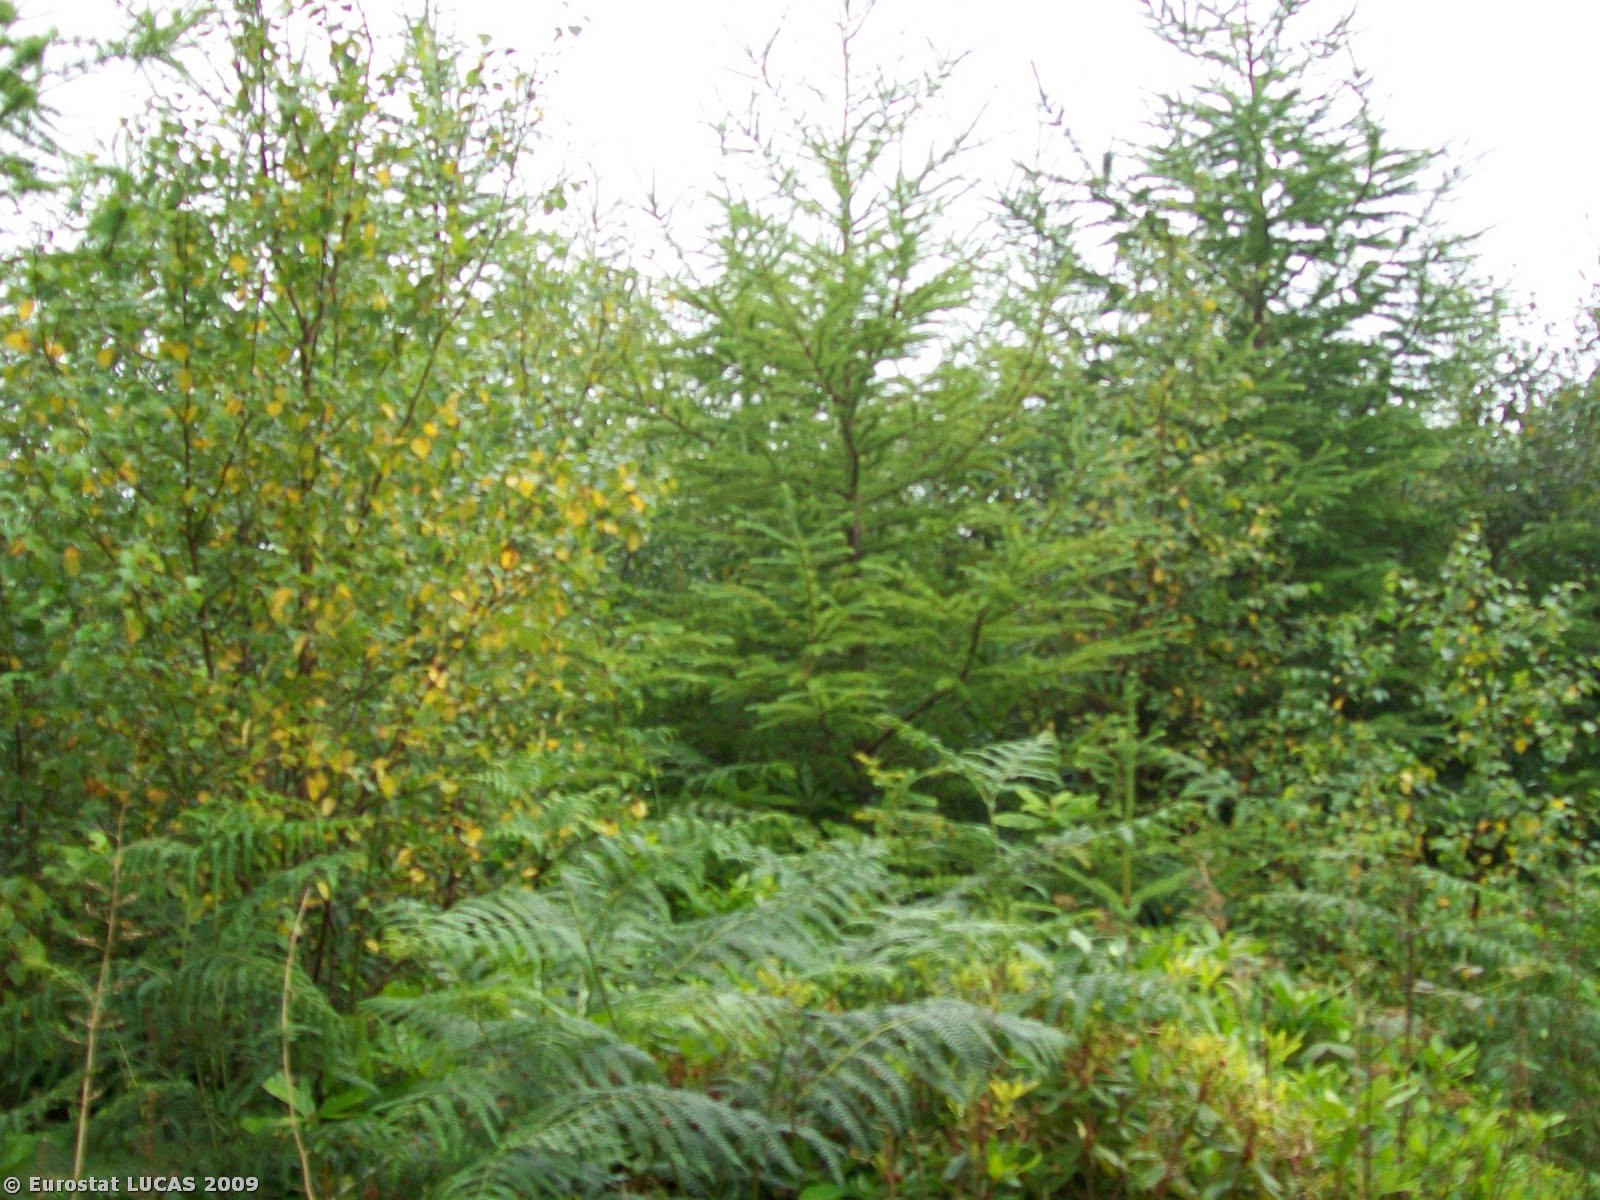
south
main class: Woodland
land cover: Mixed woodland
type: hemiboreal forest and nemoral coniferous forest and mixed broadleaved-coniferous forest
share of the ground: > 75 %
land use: Forestry
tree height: > 5 m
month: July
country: IE
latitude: 53.6600
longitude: -8.9598
